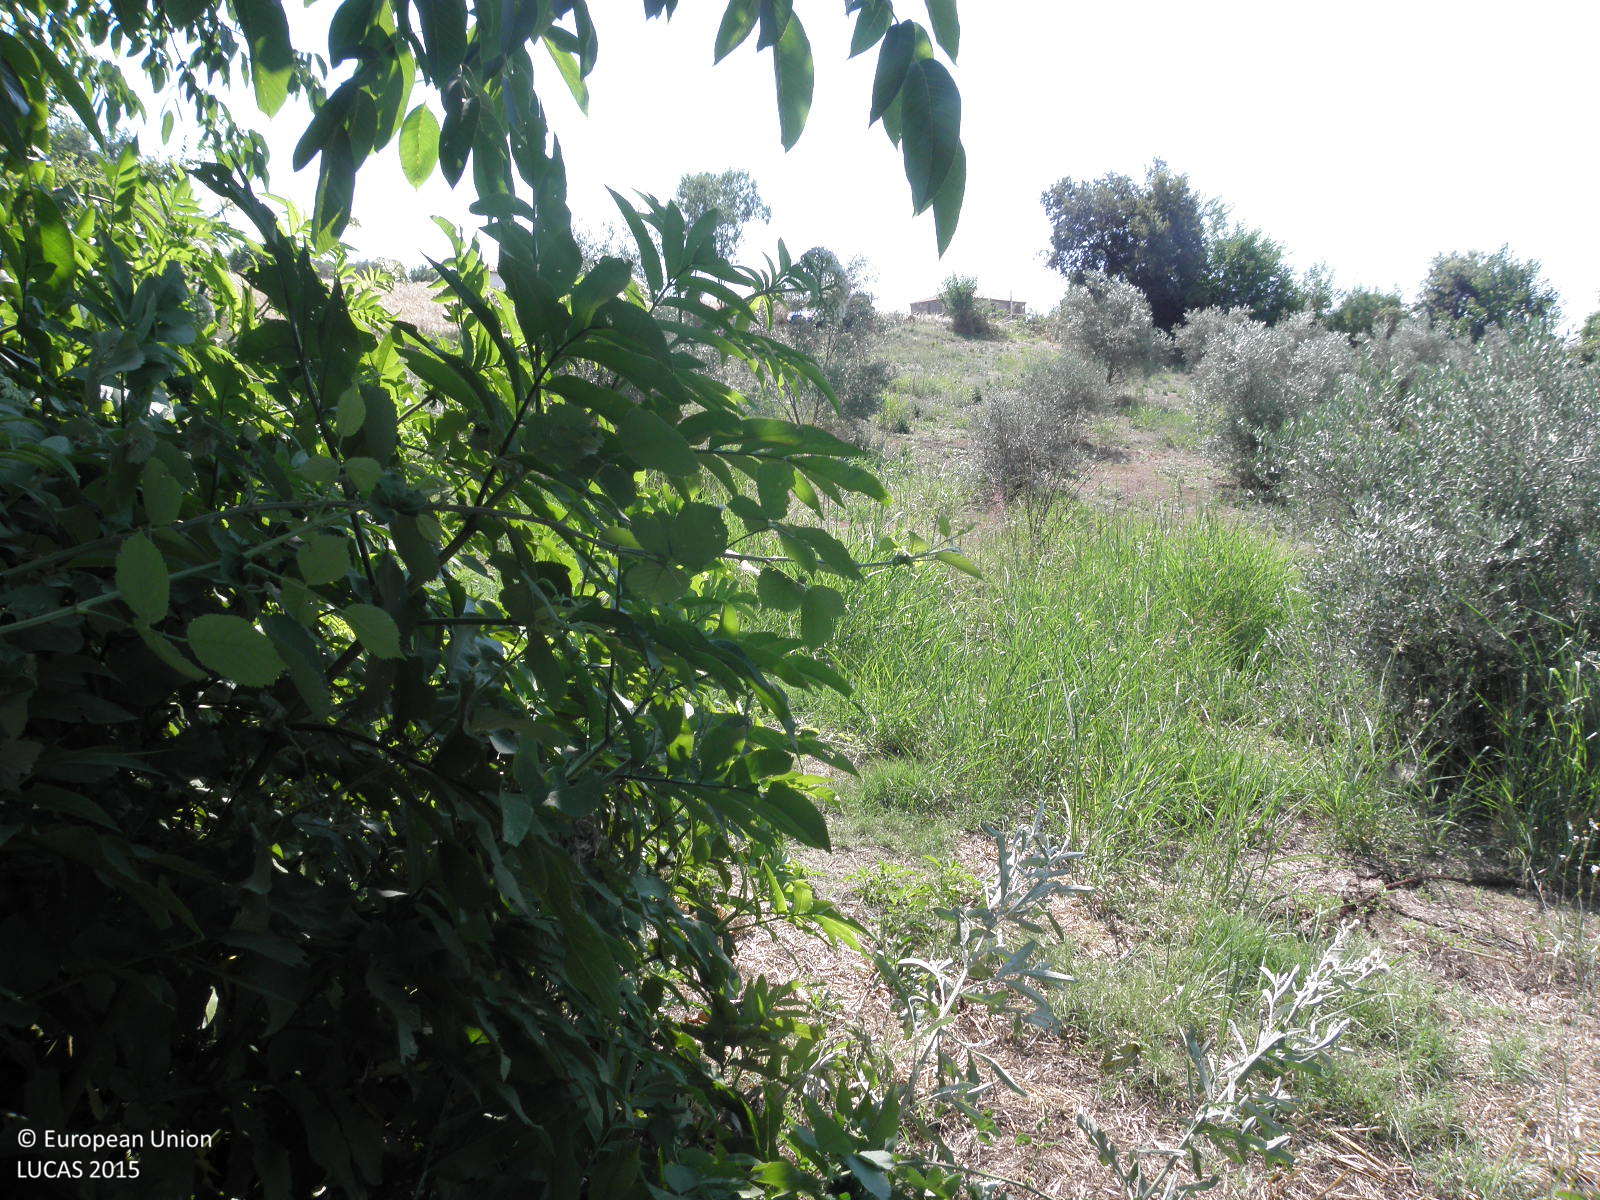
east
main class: Cropland
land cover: Nuts trees
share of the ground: 50 - 75 %
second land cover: Spontaneously vegetated surfaces
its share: > 75 %
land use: Agriculture (excluding fallow land and kitchen gardens)
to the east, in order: Nuts trees; Spontaneously vegetated surfaces; Fences; Shruby margins; Tracks; Shruby margins; Fences; Olive groves; Fences; Broadleaved woodland; Artificial constructions in urban areas; Single bushes/trees; Other bare soil; Fences; Grass margins; Tracks; Grass margins
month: June
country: GR
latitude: 40.4088
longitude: 22.5500
